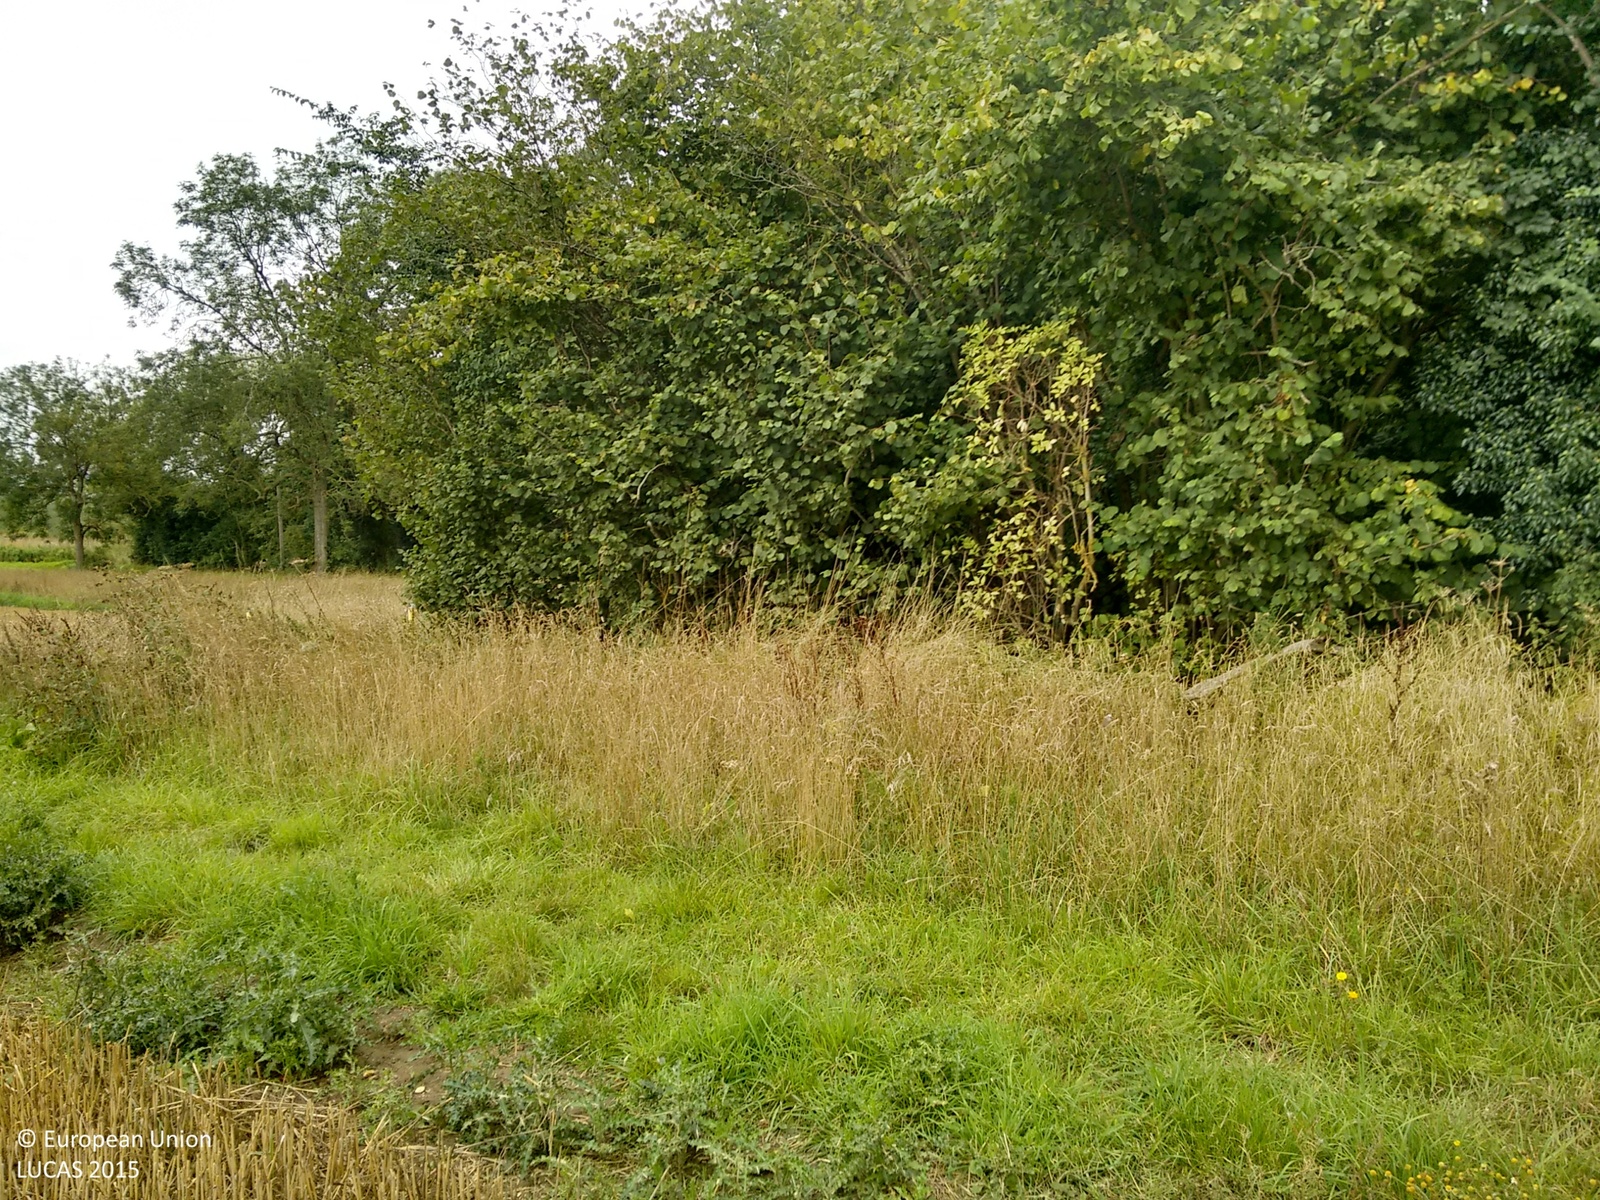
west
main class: Cropland
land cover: Common wheat
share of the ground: > 75 %
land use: Agriculture (excluding fallow land and kitchen gardens)
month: September
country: GB
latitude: 52.1740
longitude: 0.9247
